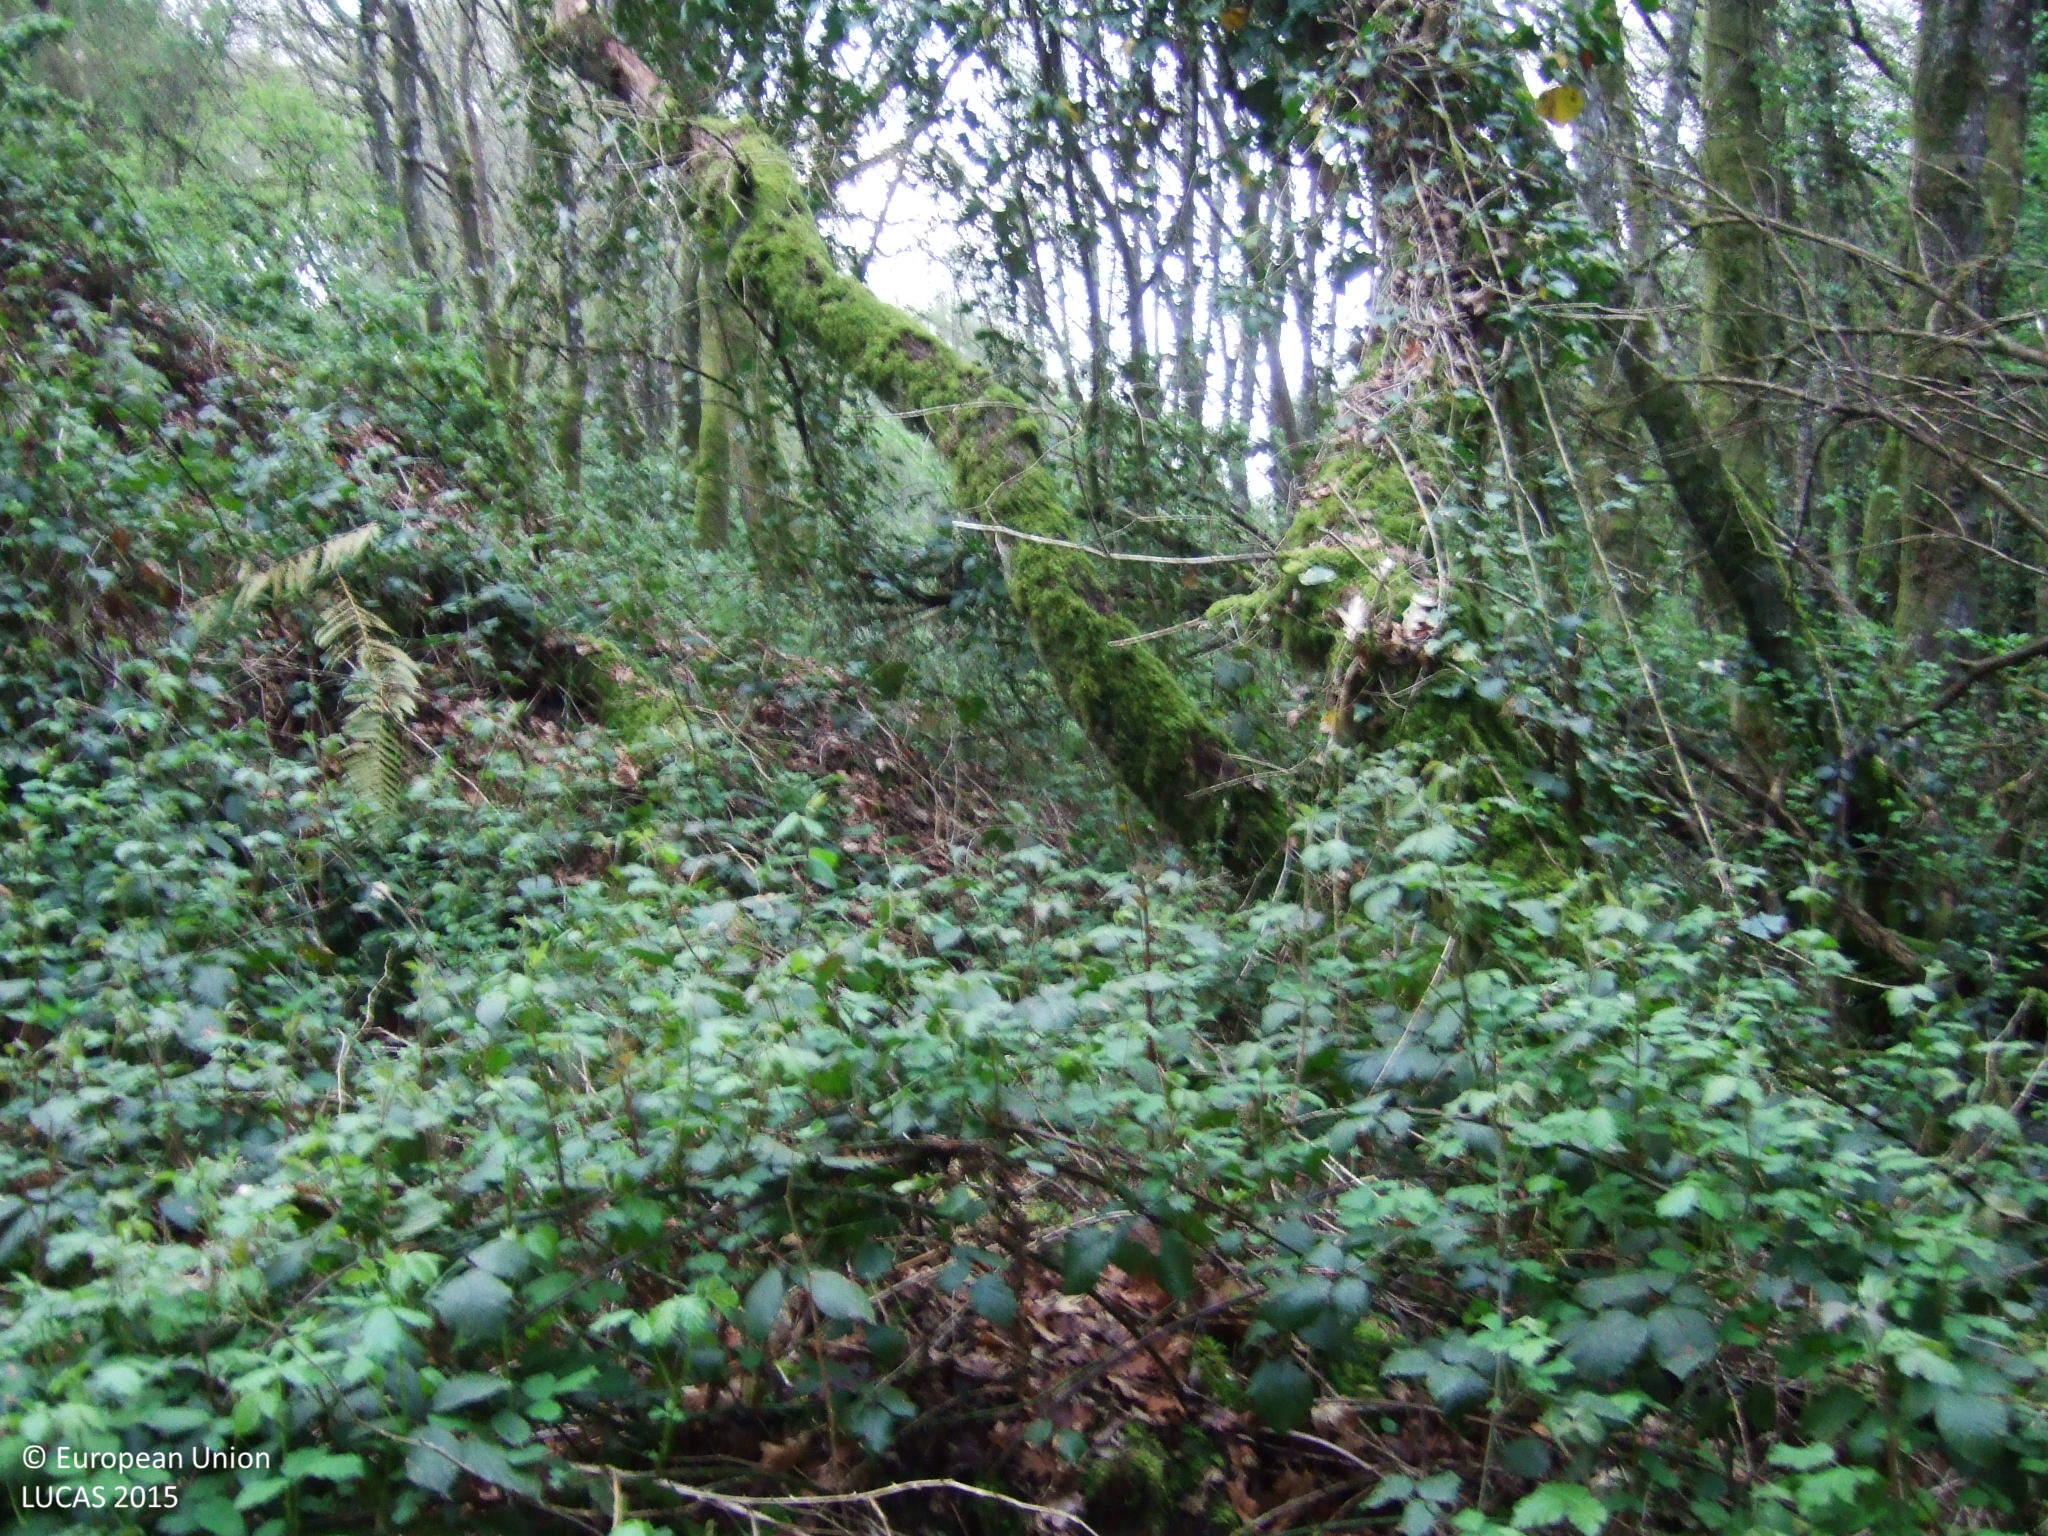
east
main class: Woodland
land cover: Broadleaved woodland
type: floodplain forest
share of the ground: > 75 %
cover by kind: broadleaved forest trees 90 %, shrubs 10 %
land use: Forestry
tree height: > 5 m
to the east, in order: Broadleaved woodland; Inland fresh running water; Broadleaved woodland; Grassland without tree/shrub cover
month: April
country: ES
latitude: 42.9481
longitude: -7.5666
